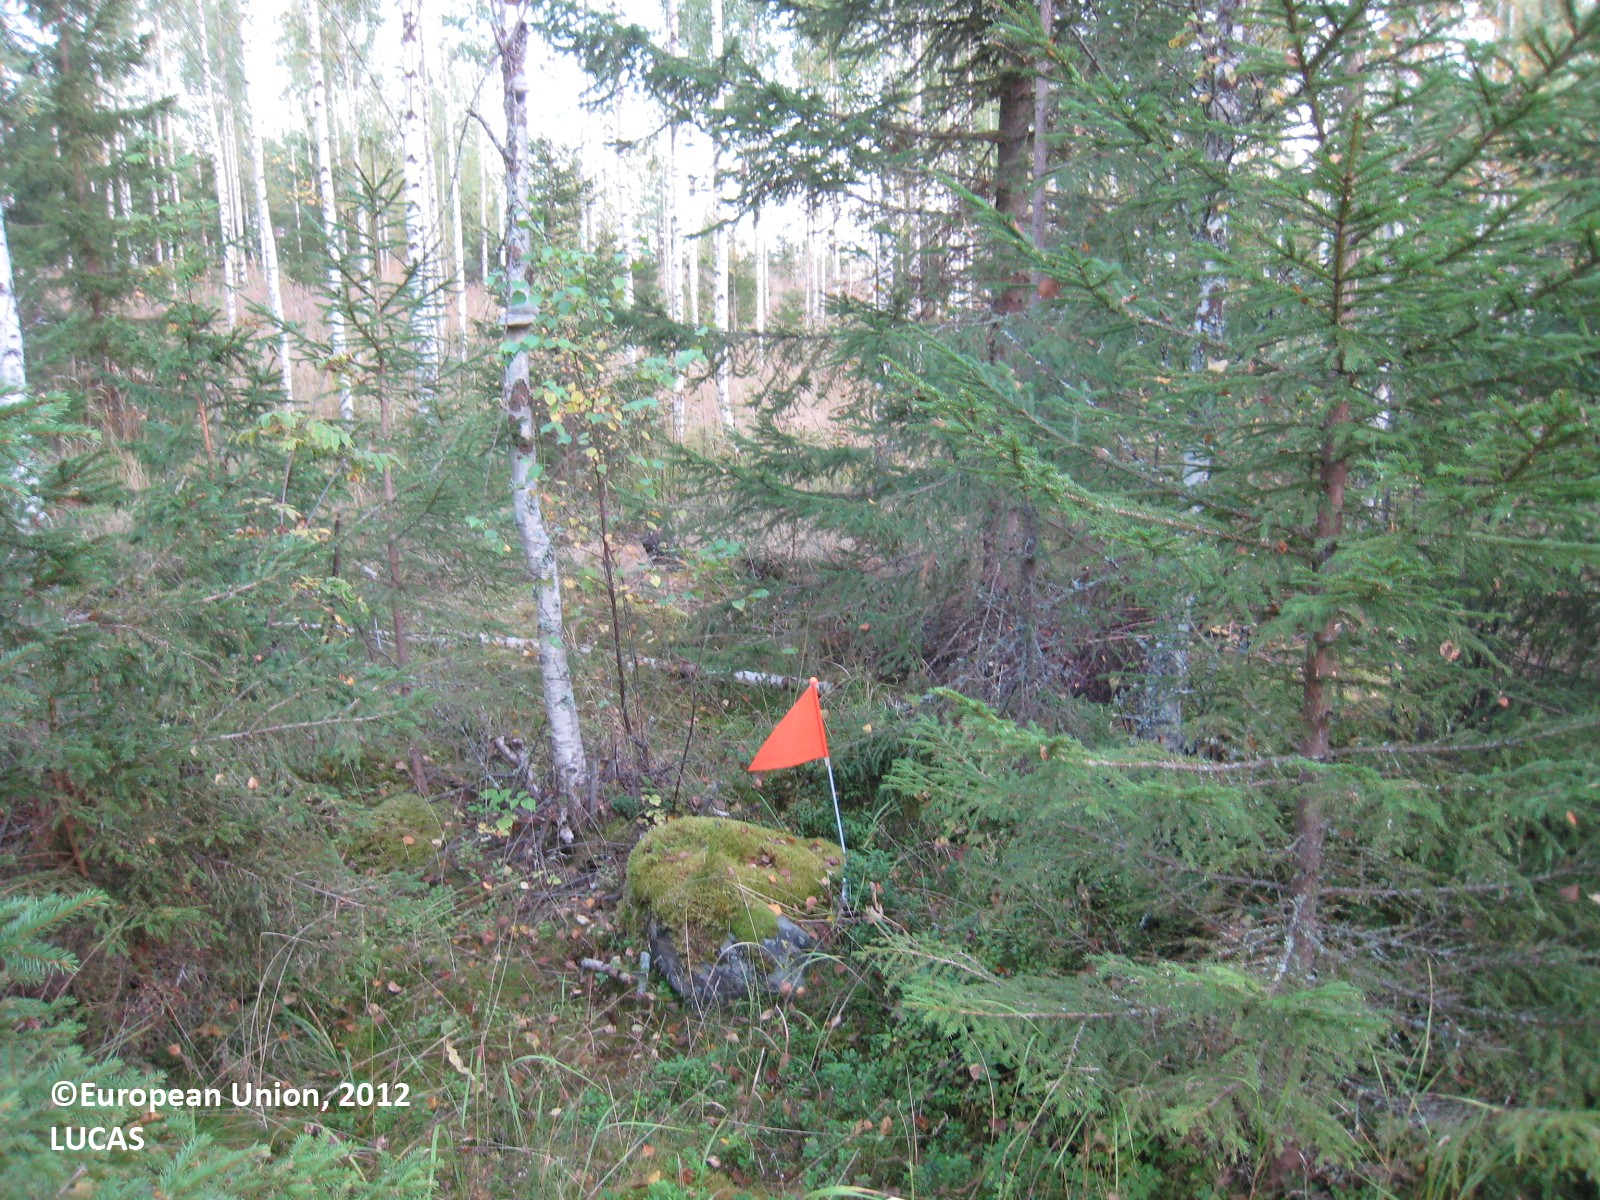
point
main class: Woodland
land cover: Spruce dominated mixed woodland
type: boreal forest
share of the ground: 50 - 75 %
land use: Forestry
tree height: > 5 m
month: September
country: FI
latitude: 62.6403
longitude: 26.4600
